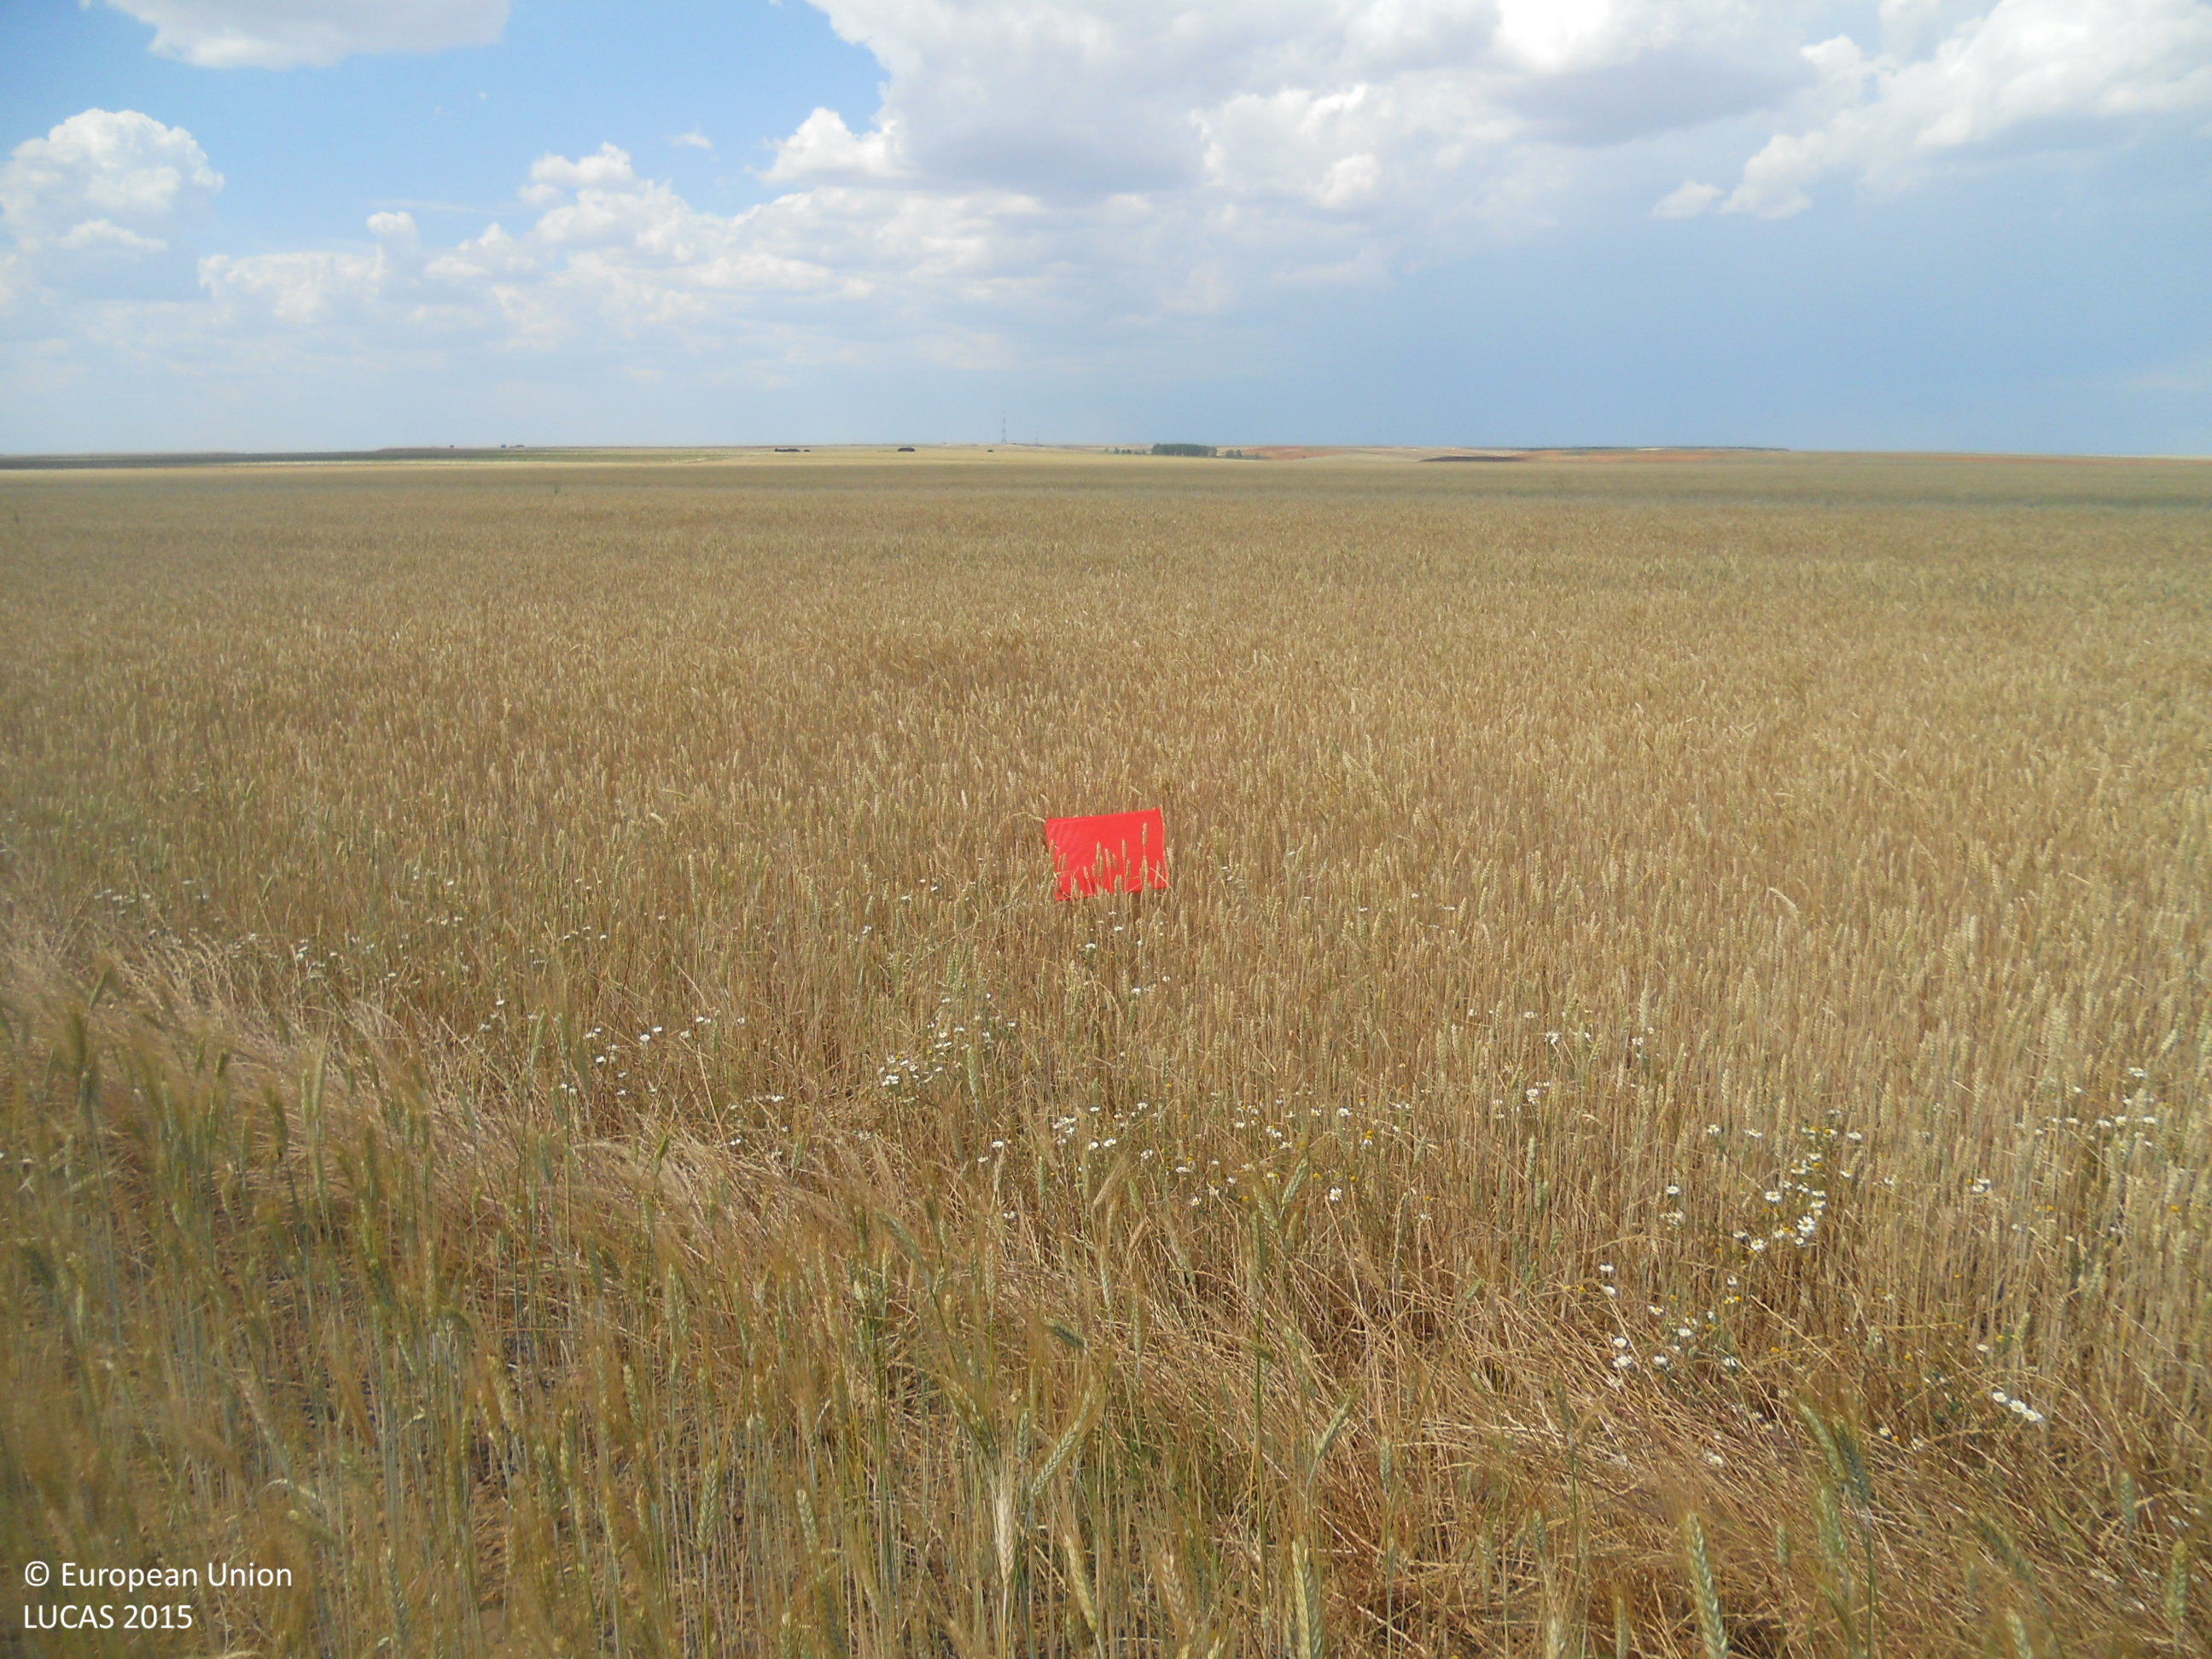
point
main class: Cropland
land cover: Common wheat
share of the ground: > 75 %
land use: Agriculture (excluding fallow land and kitchen gardens)
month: June
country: ES
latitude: 42.2823
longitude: -5.3562
